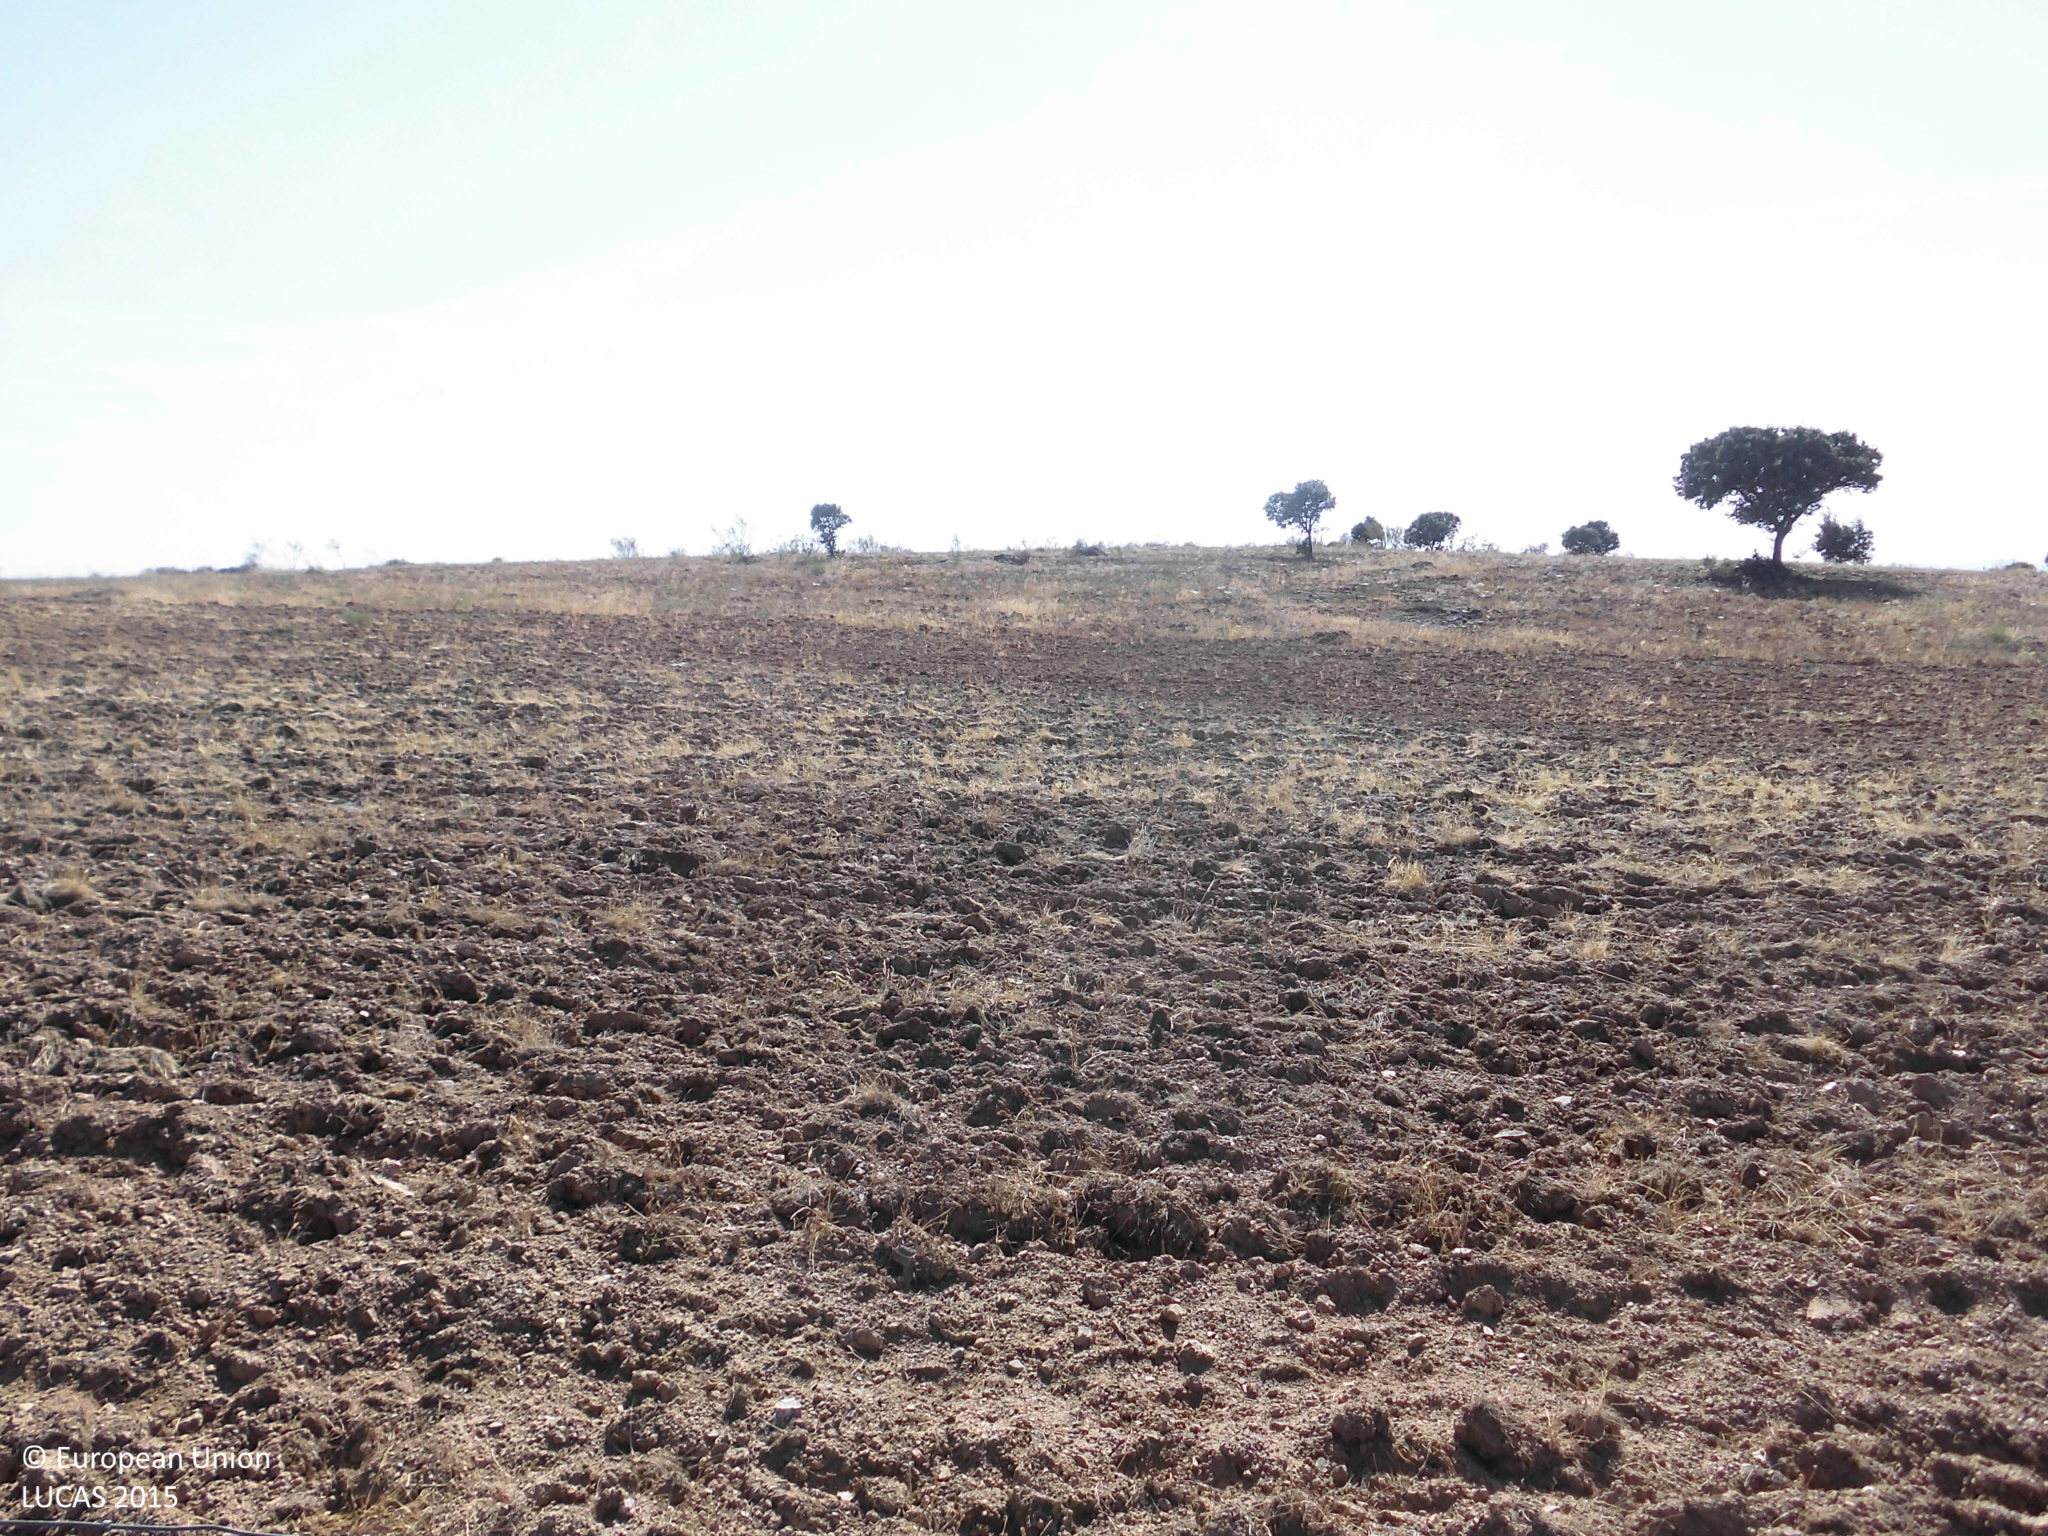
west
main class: Grassland
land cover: Grassland without tree/shrub cover
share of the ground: > 75 %
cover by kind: herbaceous plants 95 %, shrubs 5 %
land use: Agriculture (excluding fallow land and kitchen gardens)
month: July
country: ES
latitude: 40.0618
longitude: -6.5776
